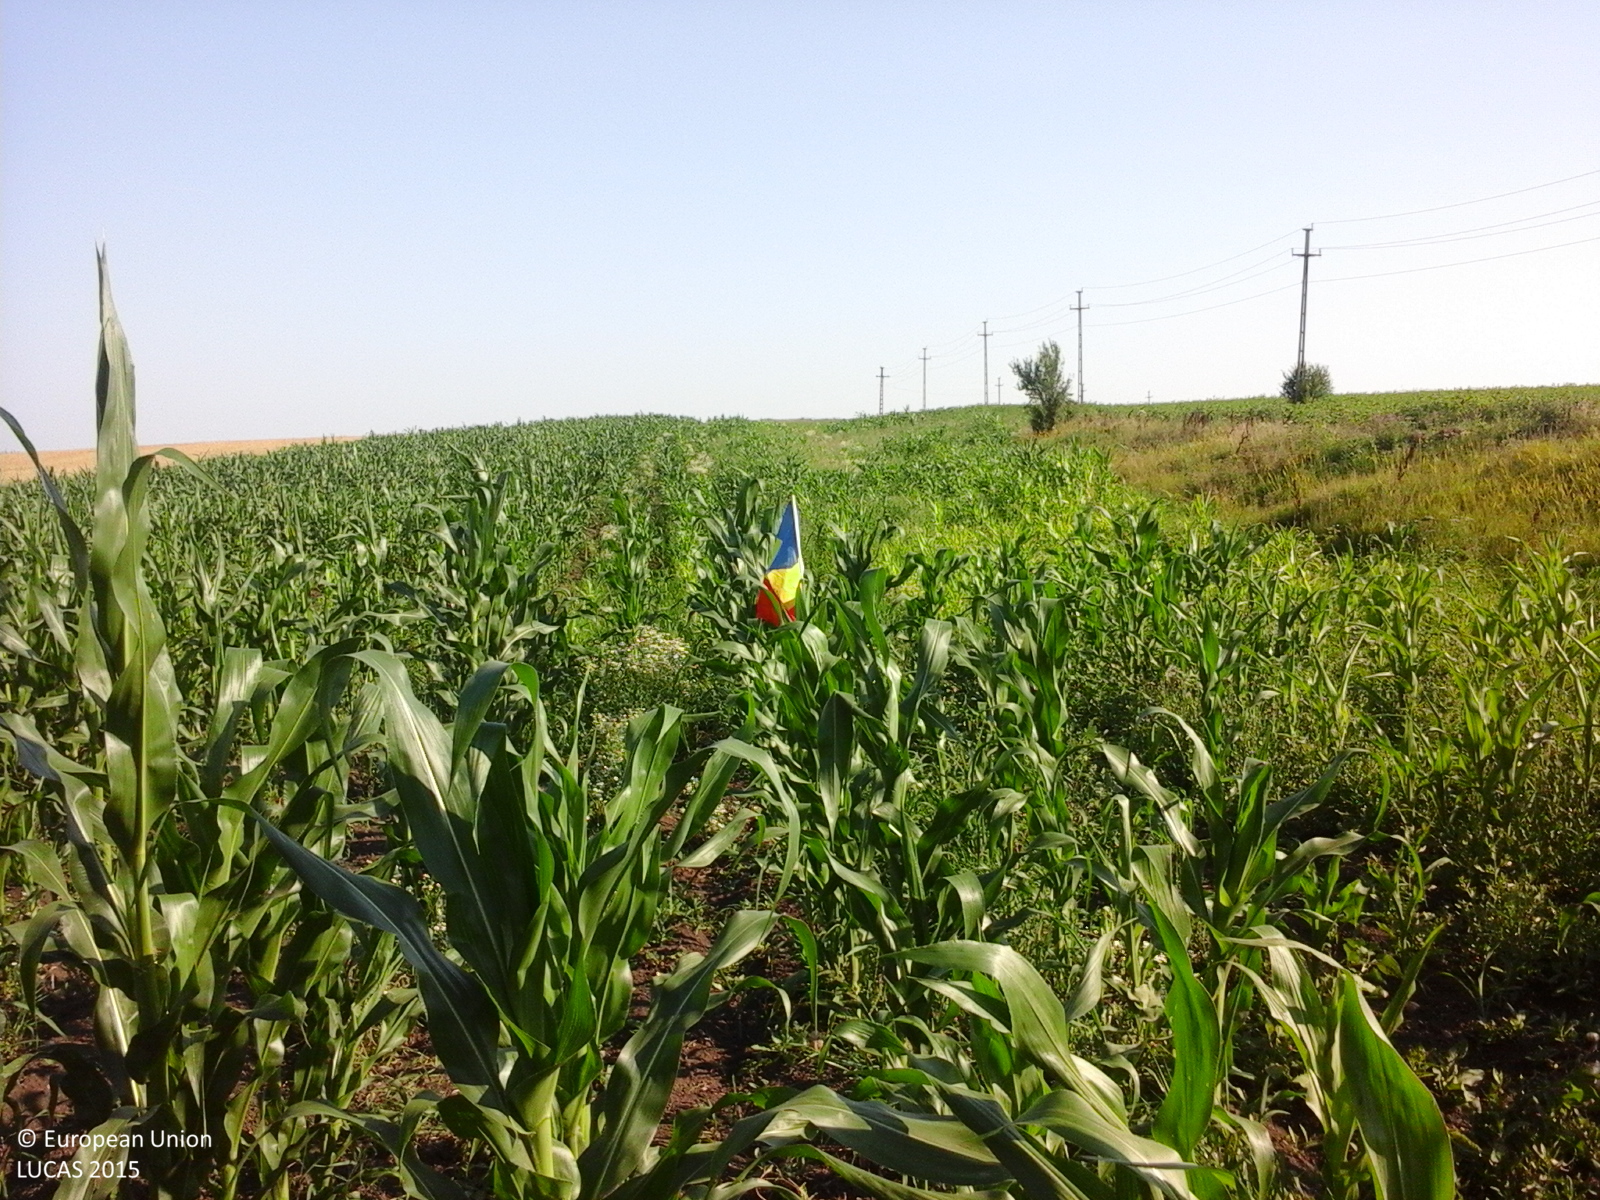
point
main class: Cropland
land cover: Maize
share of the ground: > 75 %
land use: Agriculture (excluding fallow land and kitchen gardens)
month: July
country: RO
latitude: 44.5609
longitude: 24.4357
